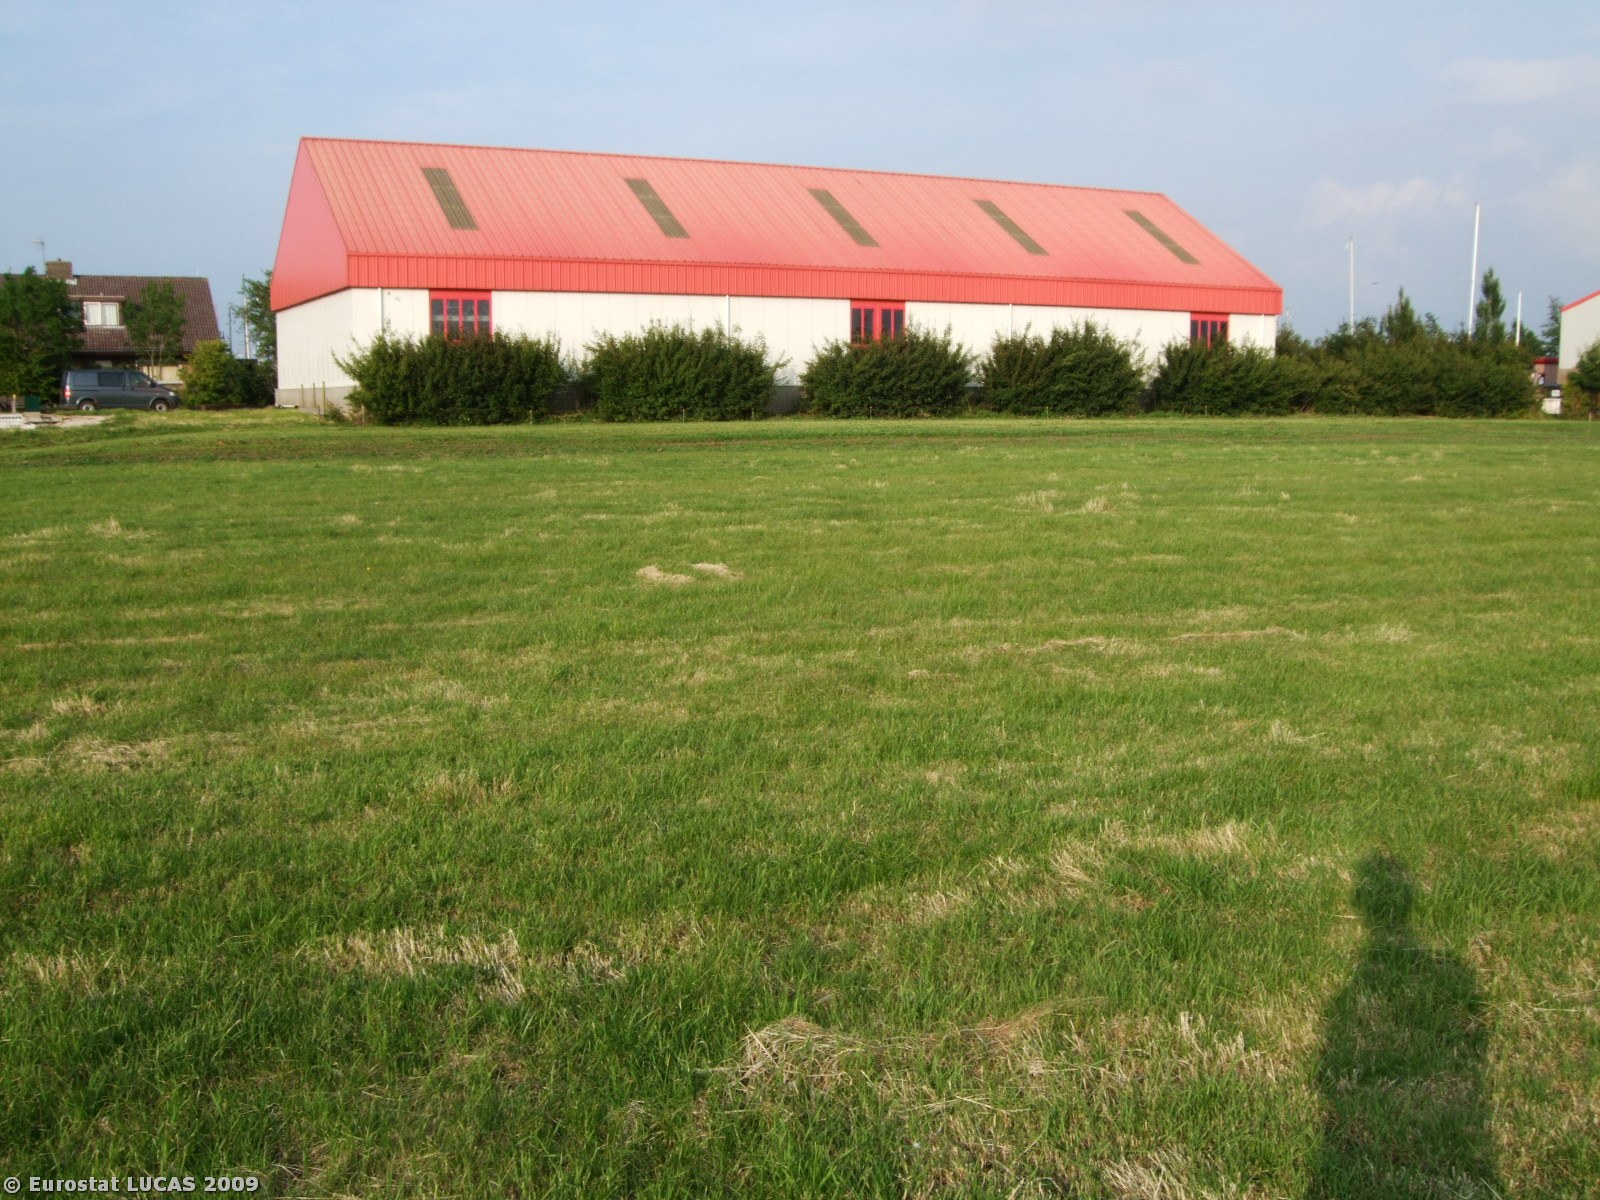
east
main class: Grassland
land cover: Grassland without tree/shrub cover
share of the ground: > 75 %
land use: Agriculture (excluding fallow land and kitchen gardens)
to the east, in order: Grassland without tree/shrub cover; Artificial constructions in urban areas; Inland water bodies; Artificial constructions in urban areas
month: June
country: NL
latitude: 52.8916
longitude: 5.6439
